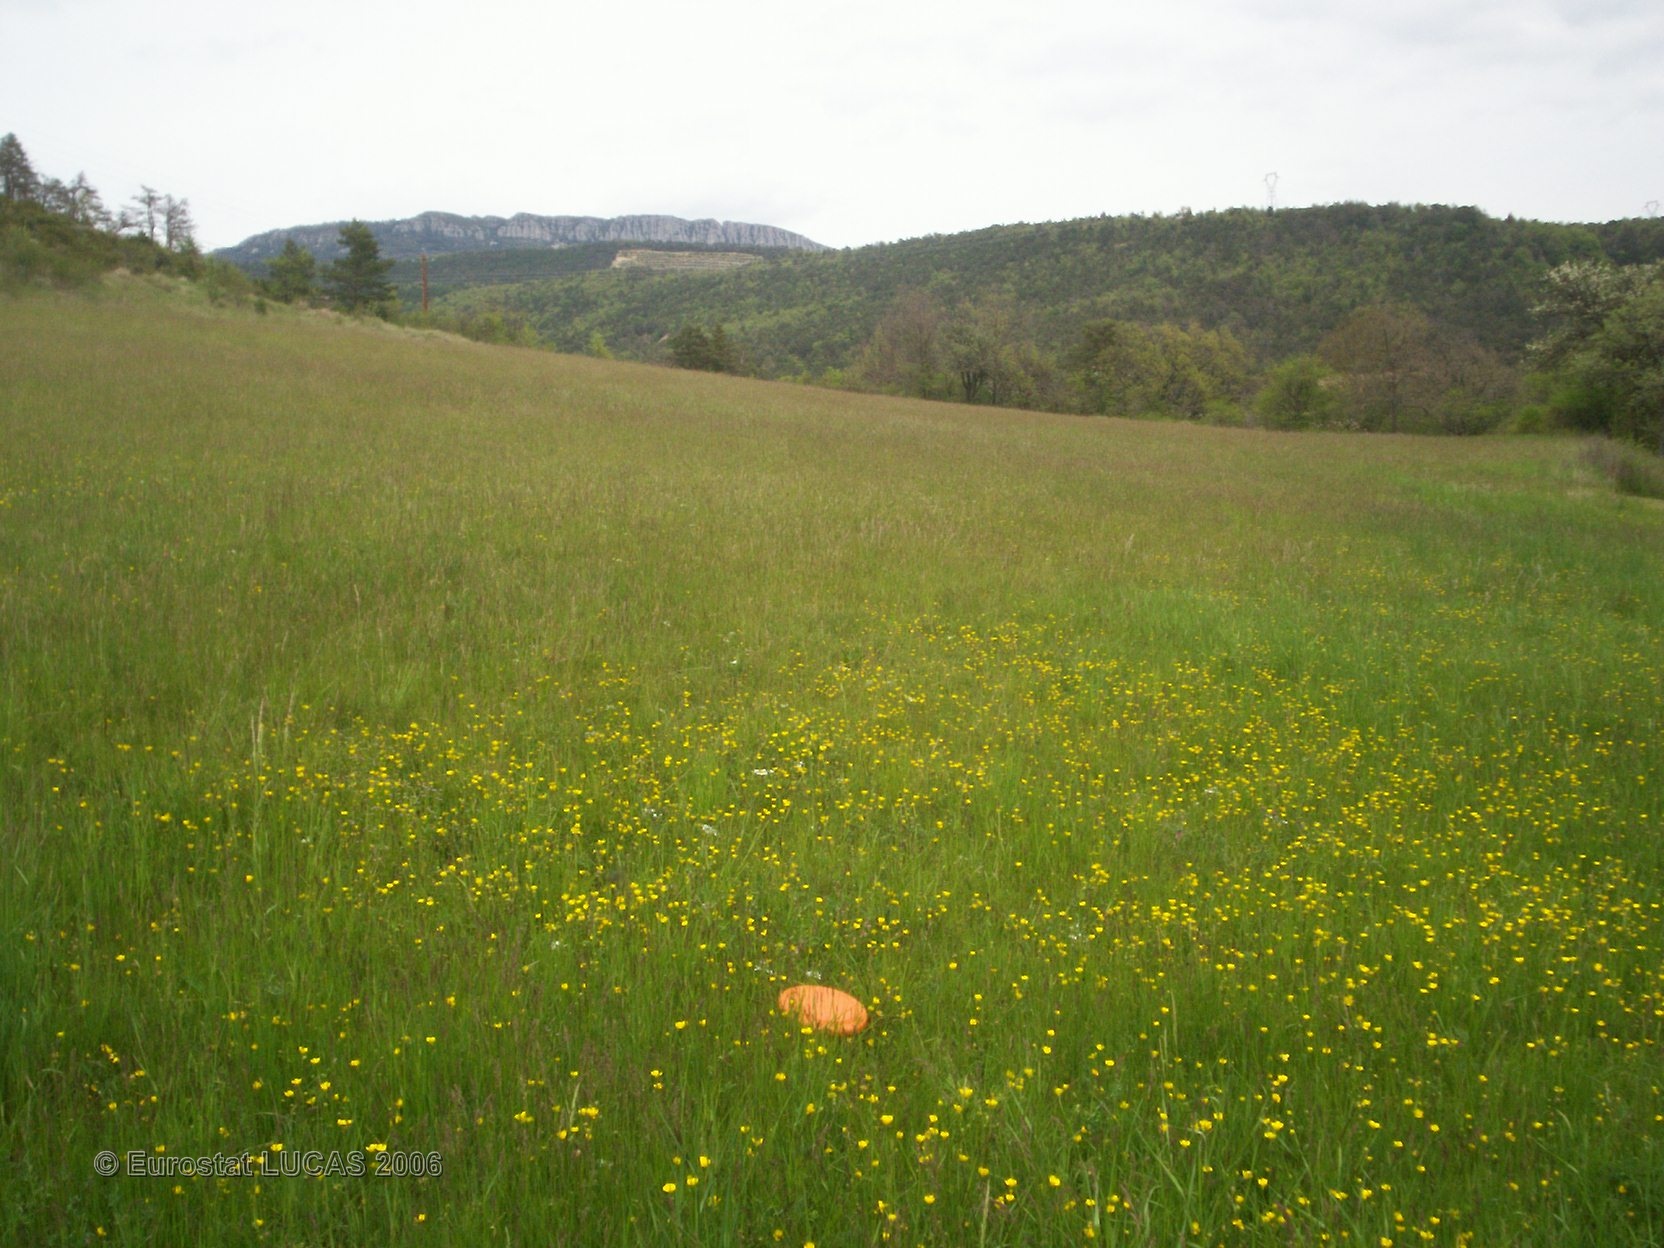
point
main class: Grassland
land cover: Grassland without tree/shrub cover
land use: Agriculture (excluding fallow land and kitchen gardens)
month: May
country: FR
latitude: 43.7865
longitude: 6.5160
